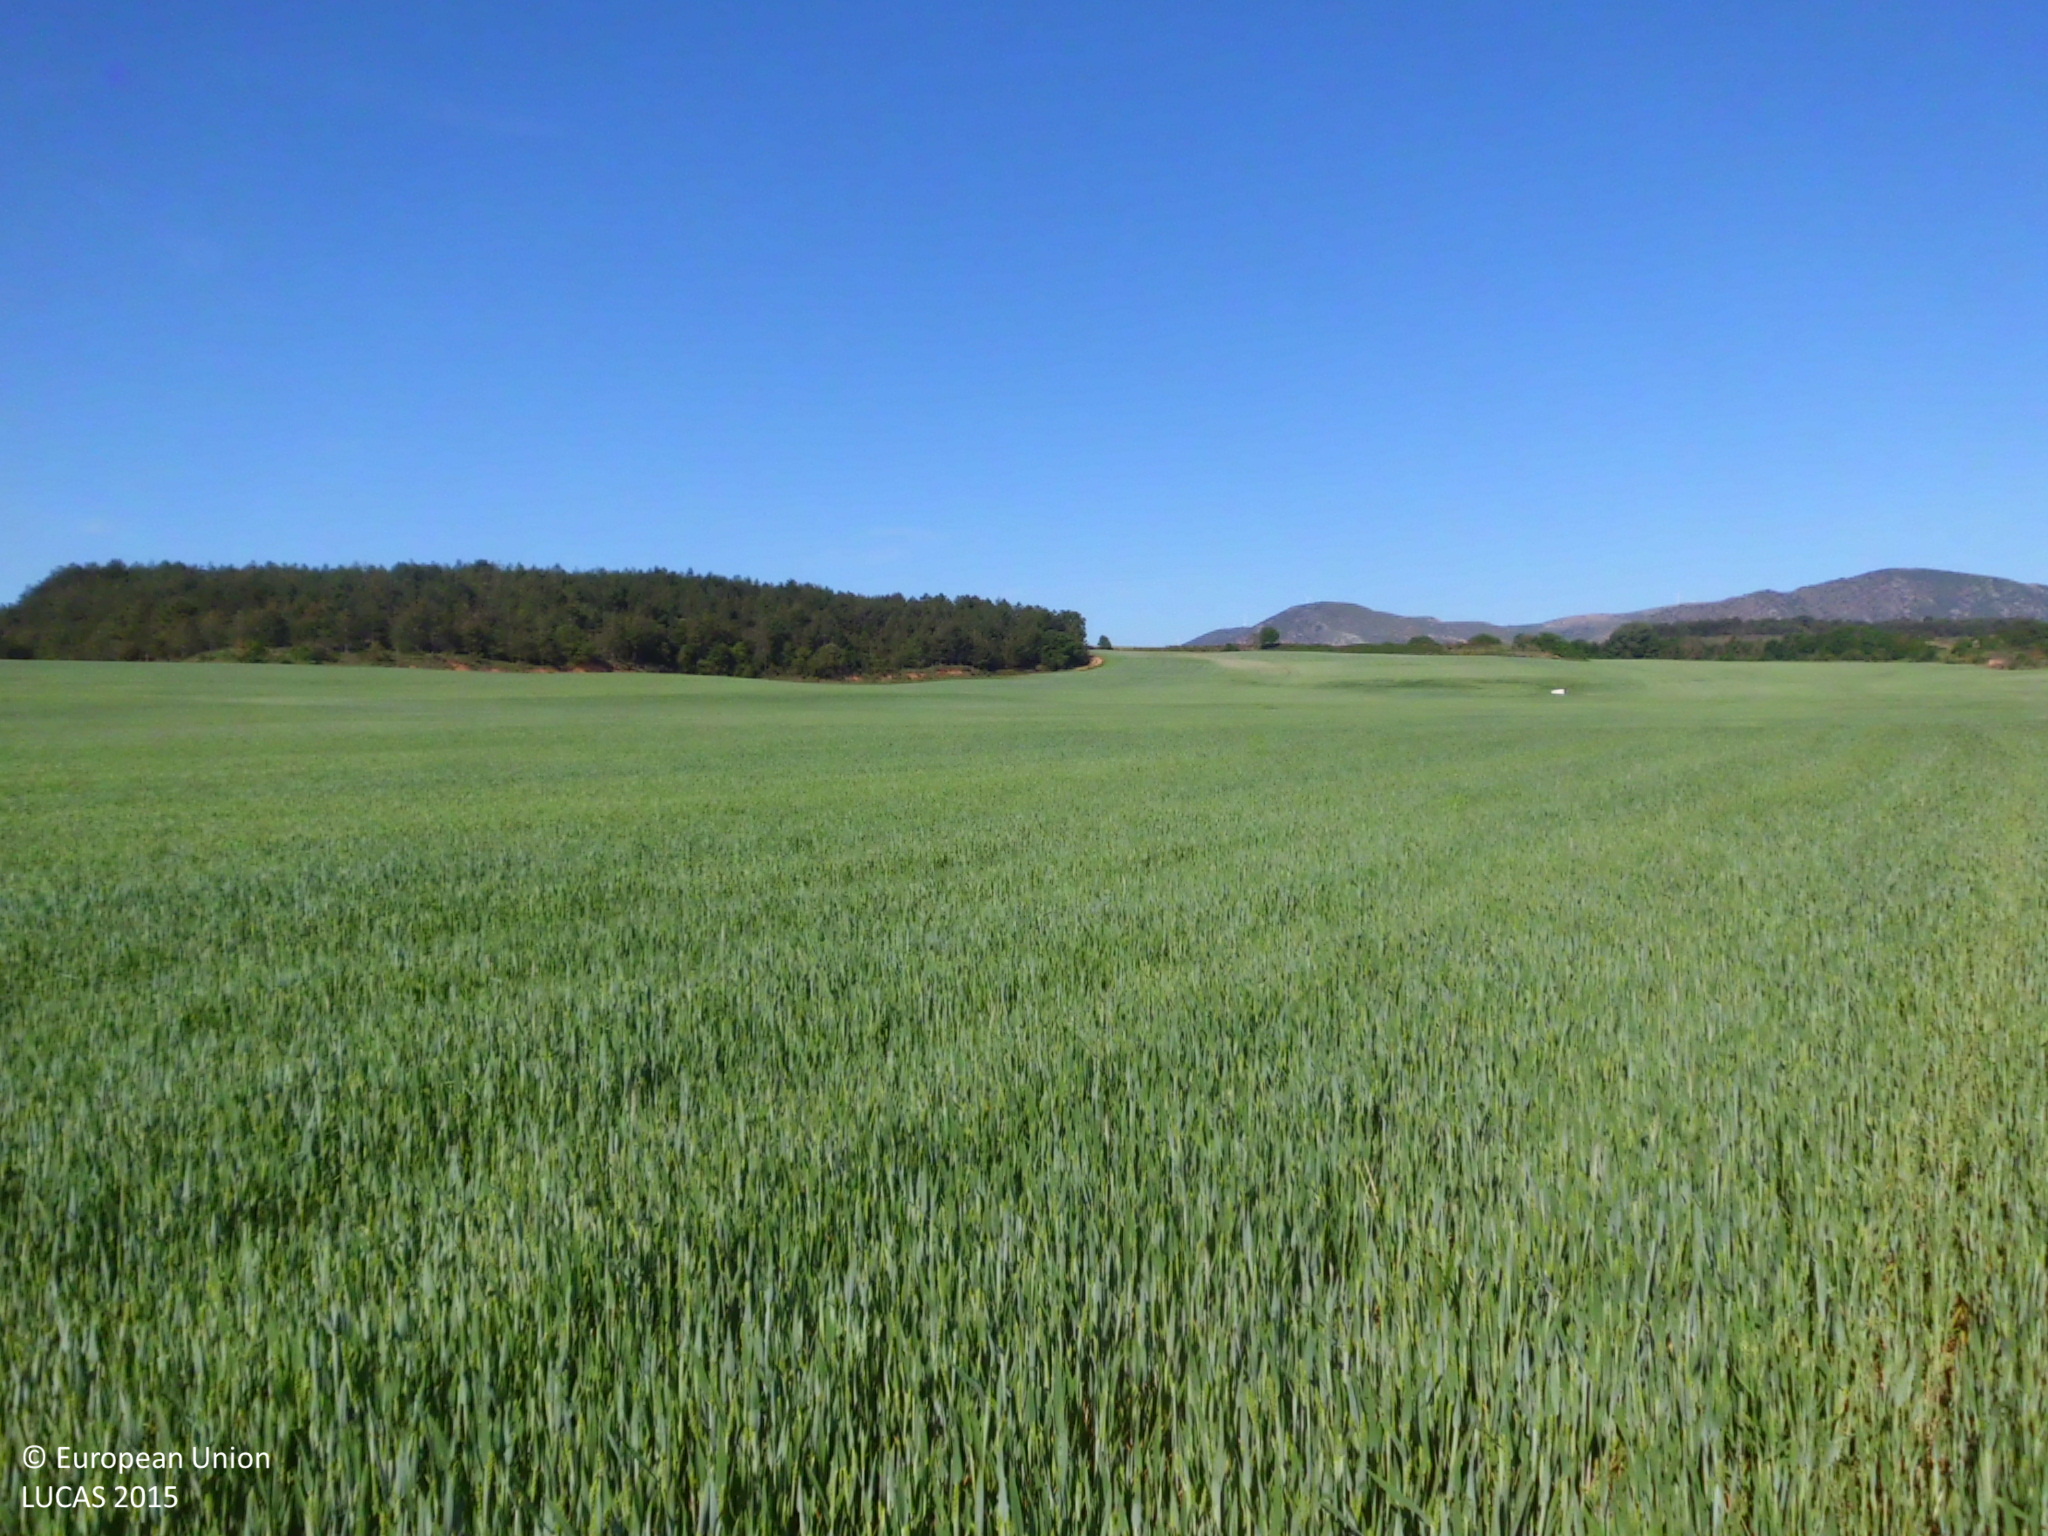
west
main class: Cropland
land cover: Common wheat
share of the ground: > 75 %
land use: Agriculture (excluding fallow land and kitchen gardens)
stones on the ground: 25 - 50 %
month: May
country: ES
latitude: 42.6671
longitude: -3.4447
